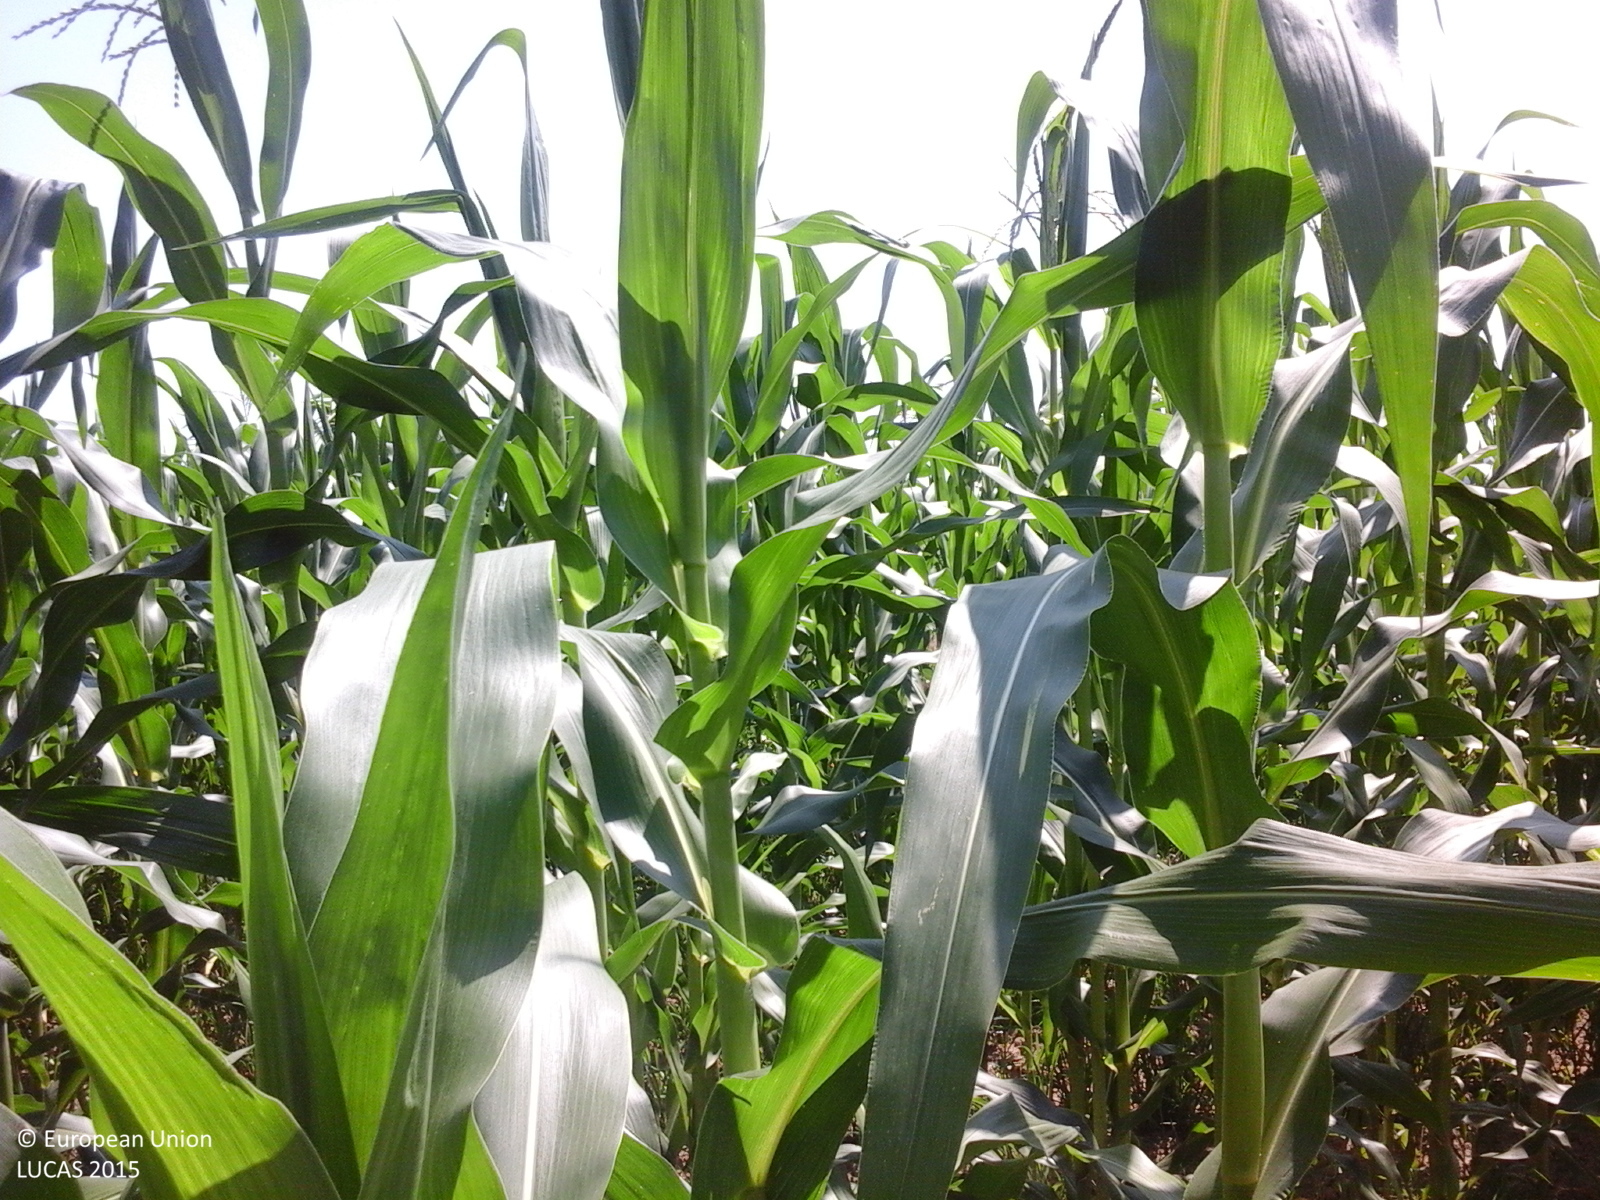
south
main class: Cropland
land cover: Maize
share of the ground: > 75 %
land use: Agriculture (excluding fallow land and kitchen gardens)
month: July
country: RO
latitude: 44.9914
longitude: 24.7558
